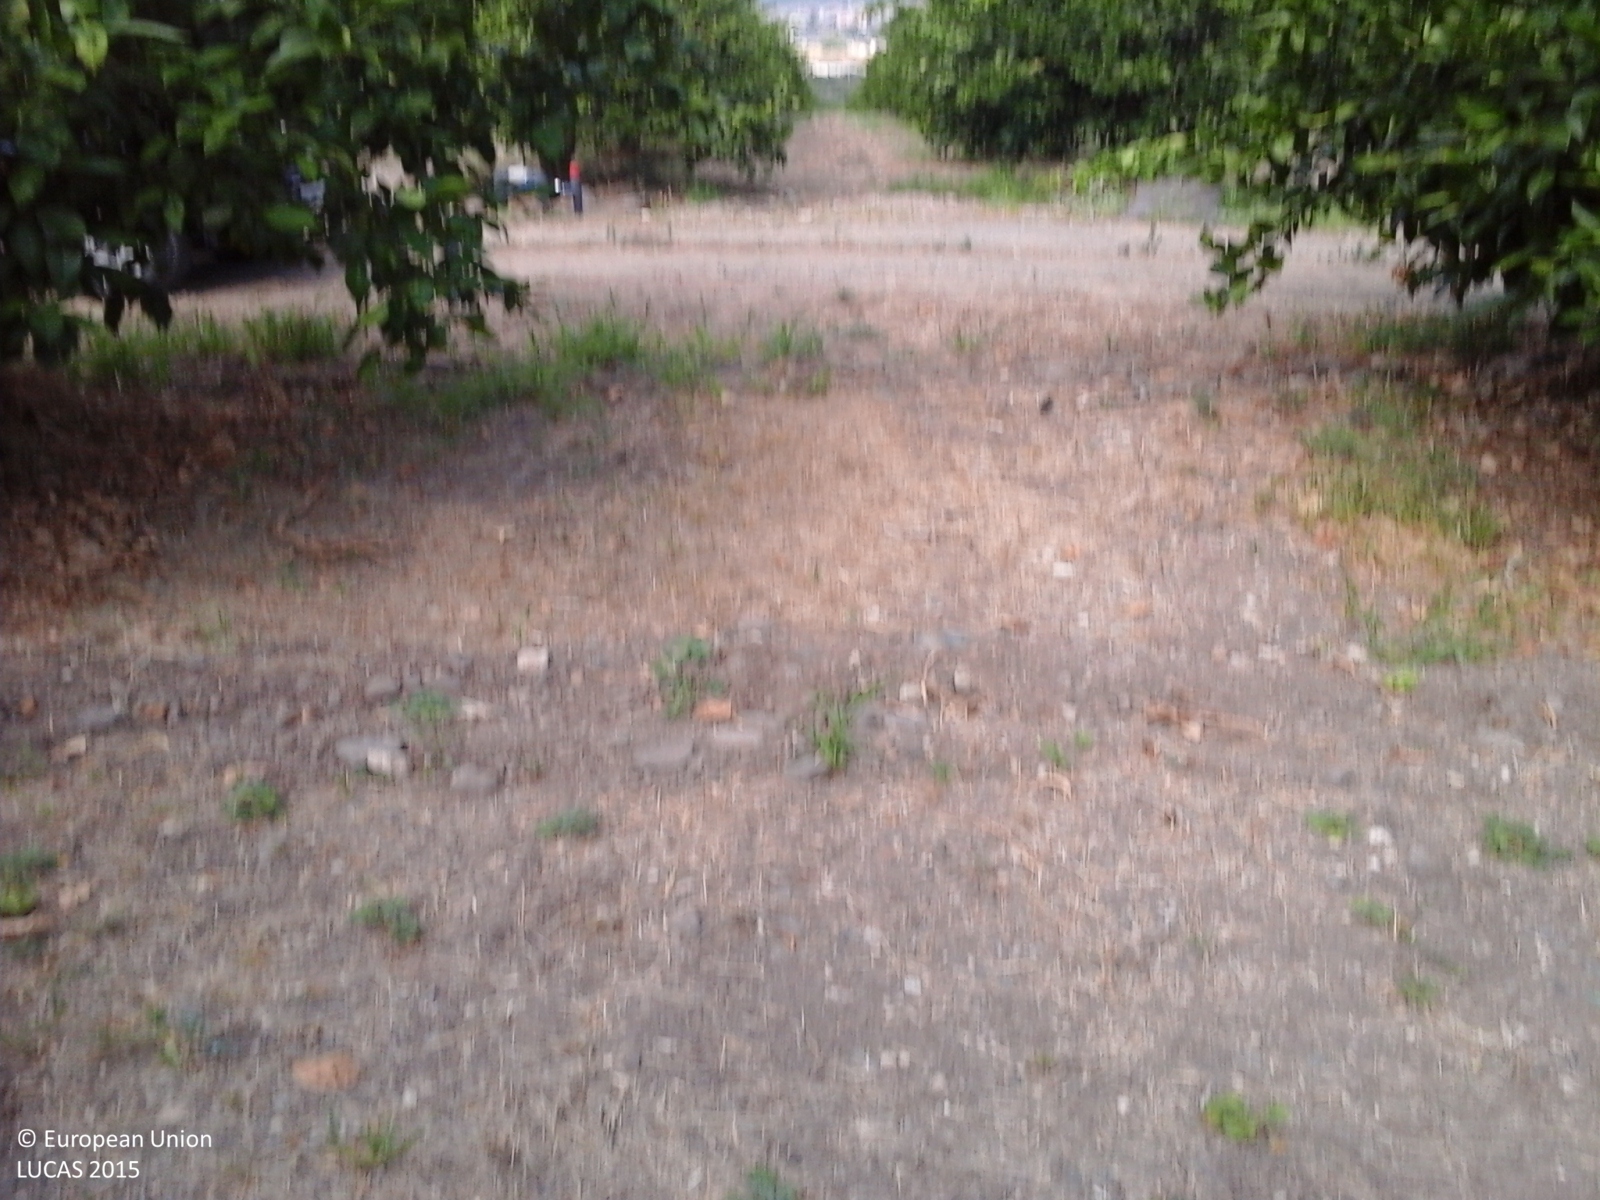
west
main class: Cropland
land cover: Oranges
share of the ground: > 75 %
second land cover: Spontaneously vegetated surfaces
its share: > 75 %
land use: Agriculture (excluding fallow land and kitchen gardens)
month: August
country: IT
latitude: 37.2953
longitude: 14.8708
